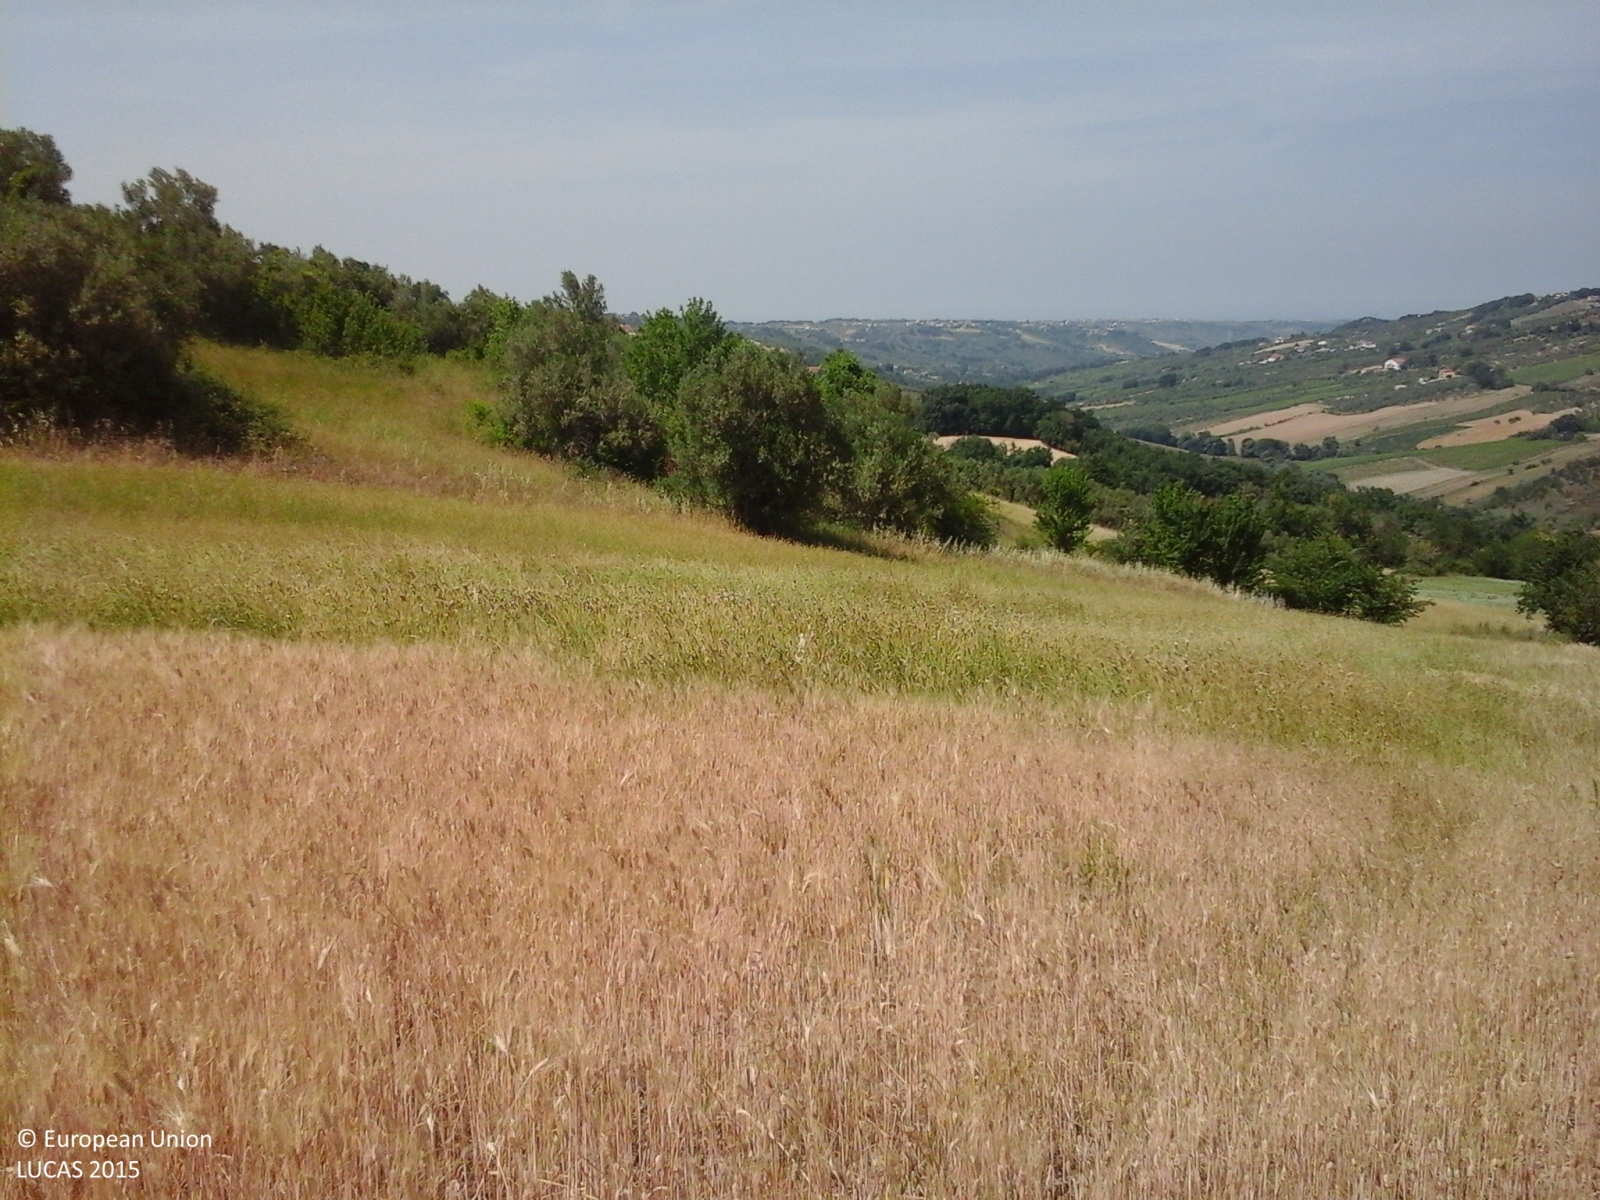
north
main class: Cropland
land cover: Olive groves
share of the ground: 25 - 50 %
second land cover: Spontaneously vegetated surfaces
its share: 25 - 50 %
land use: Agriculture (excluding fallow land and kitchen gardens)
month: June
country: IT
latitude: 42.1985
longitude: 14.3584
